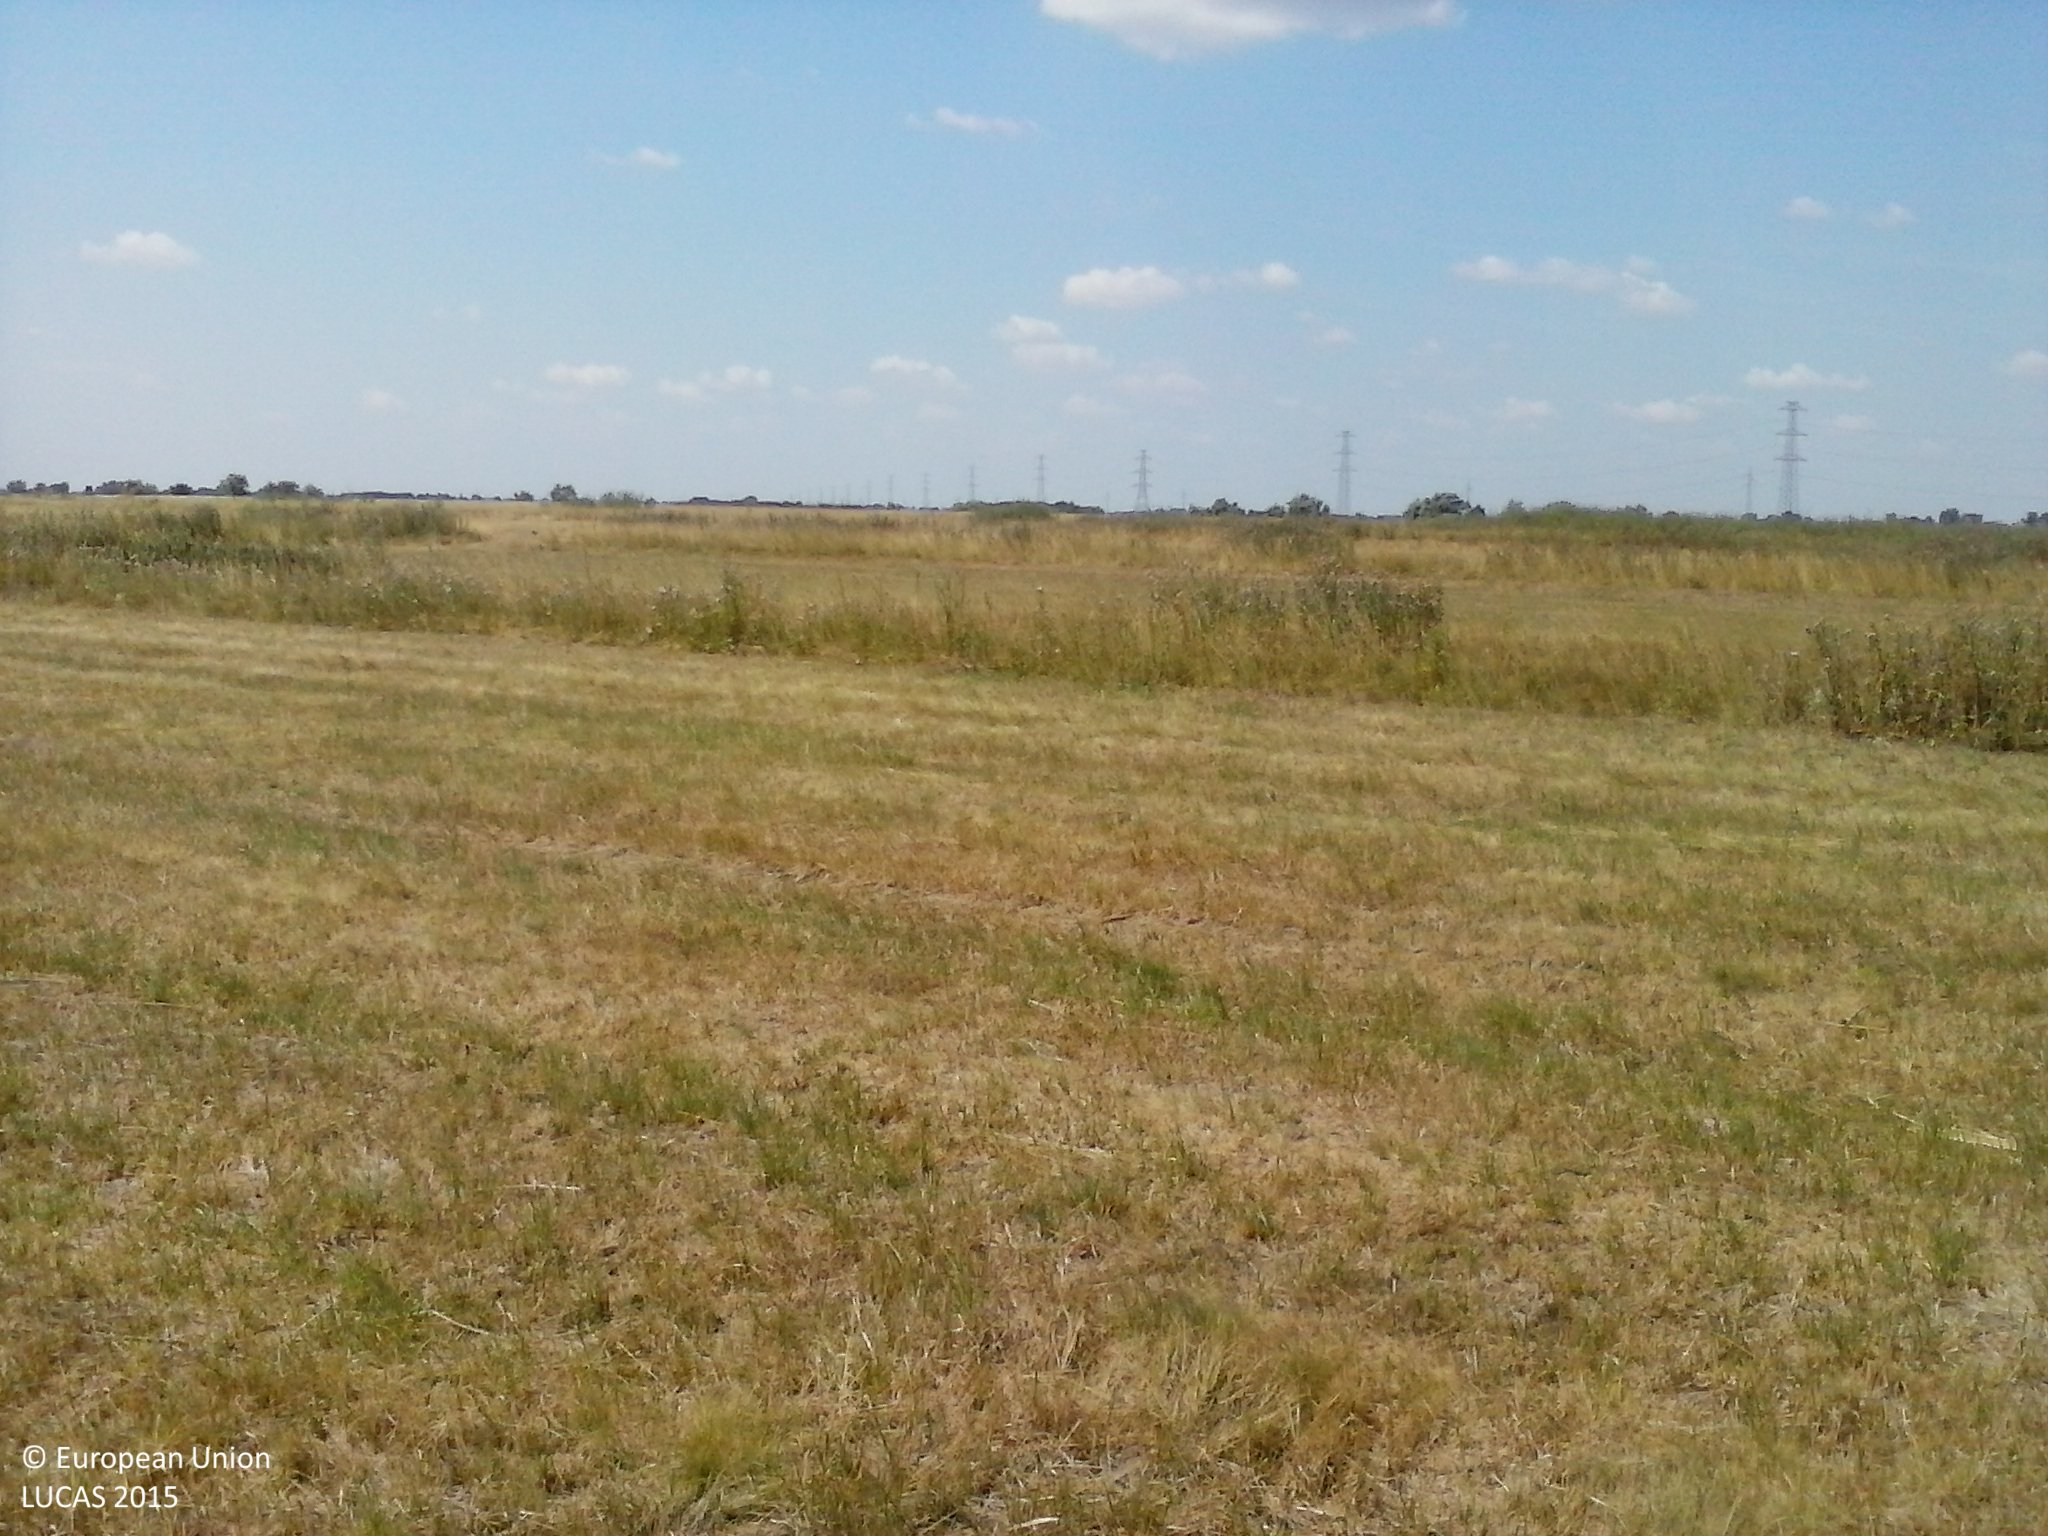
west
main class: Grassland
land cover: Grassland without tree/shrub cover
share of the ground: > 75 %
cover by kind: herbaceous plants 100 %
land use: Agriculture (excluding fallow land and kitchen gardens)
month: January
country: HU
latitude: 46.3757
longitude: 20.3338
